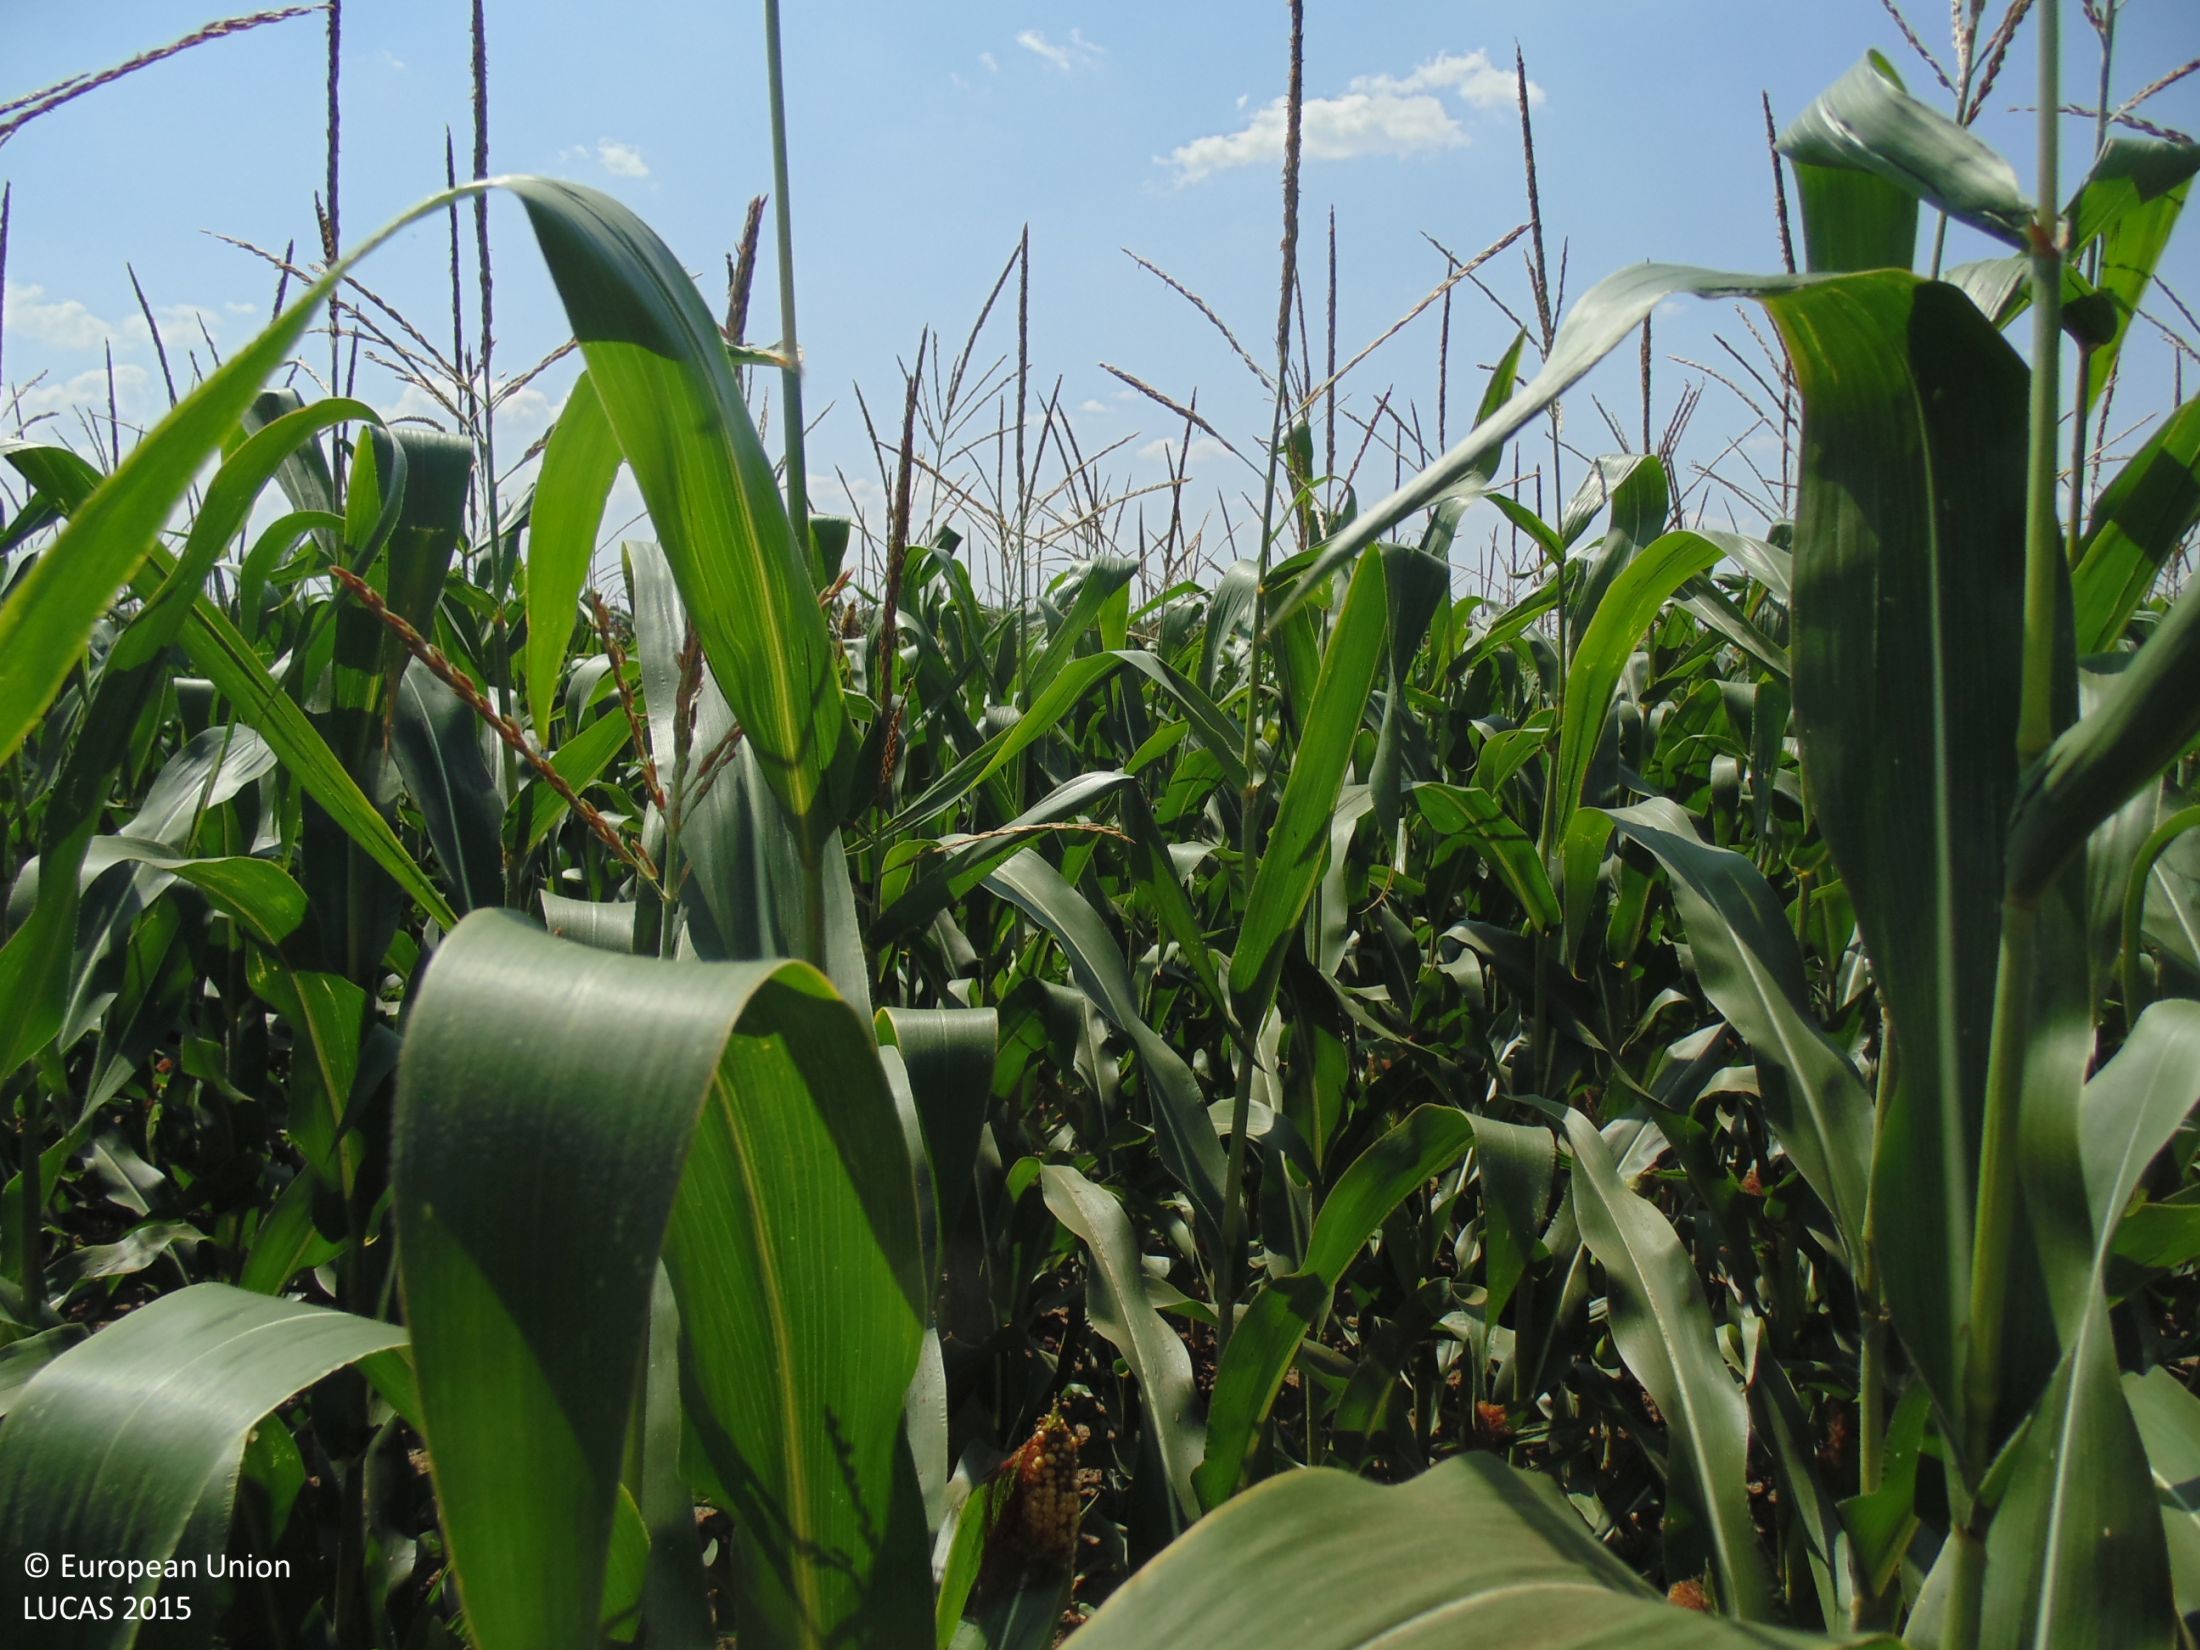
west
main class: Cropland
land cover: Maize
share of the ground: > 75 %
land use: Agriculture (excluding fallow land and kitchen gardens)
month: July
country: BG
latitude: 43.8310
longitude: 27.8922
